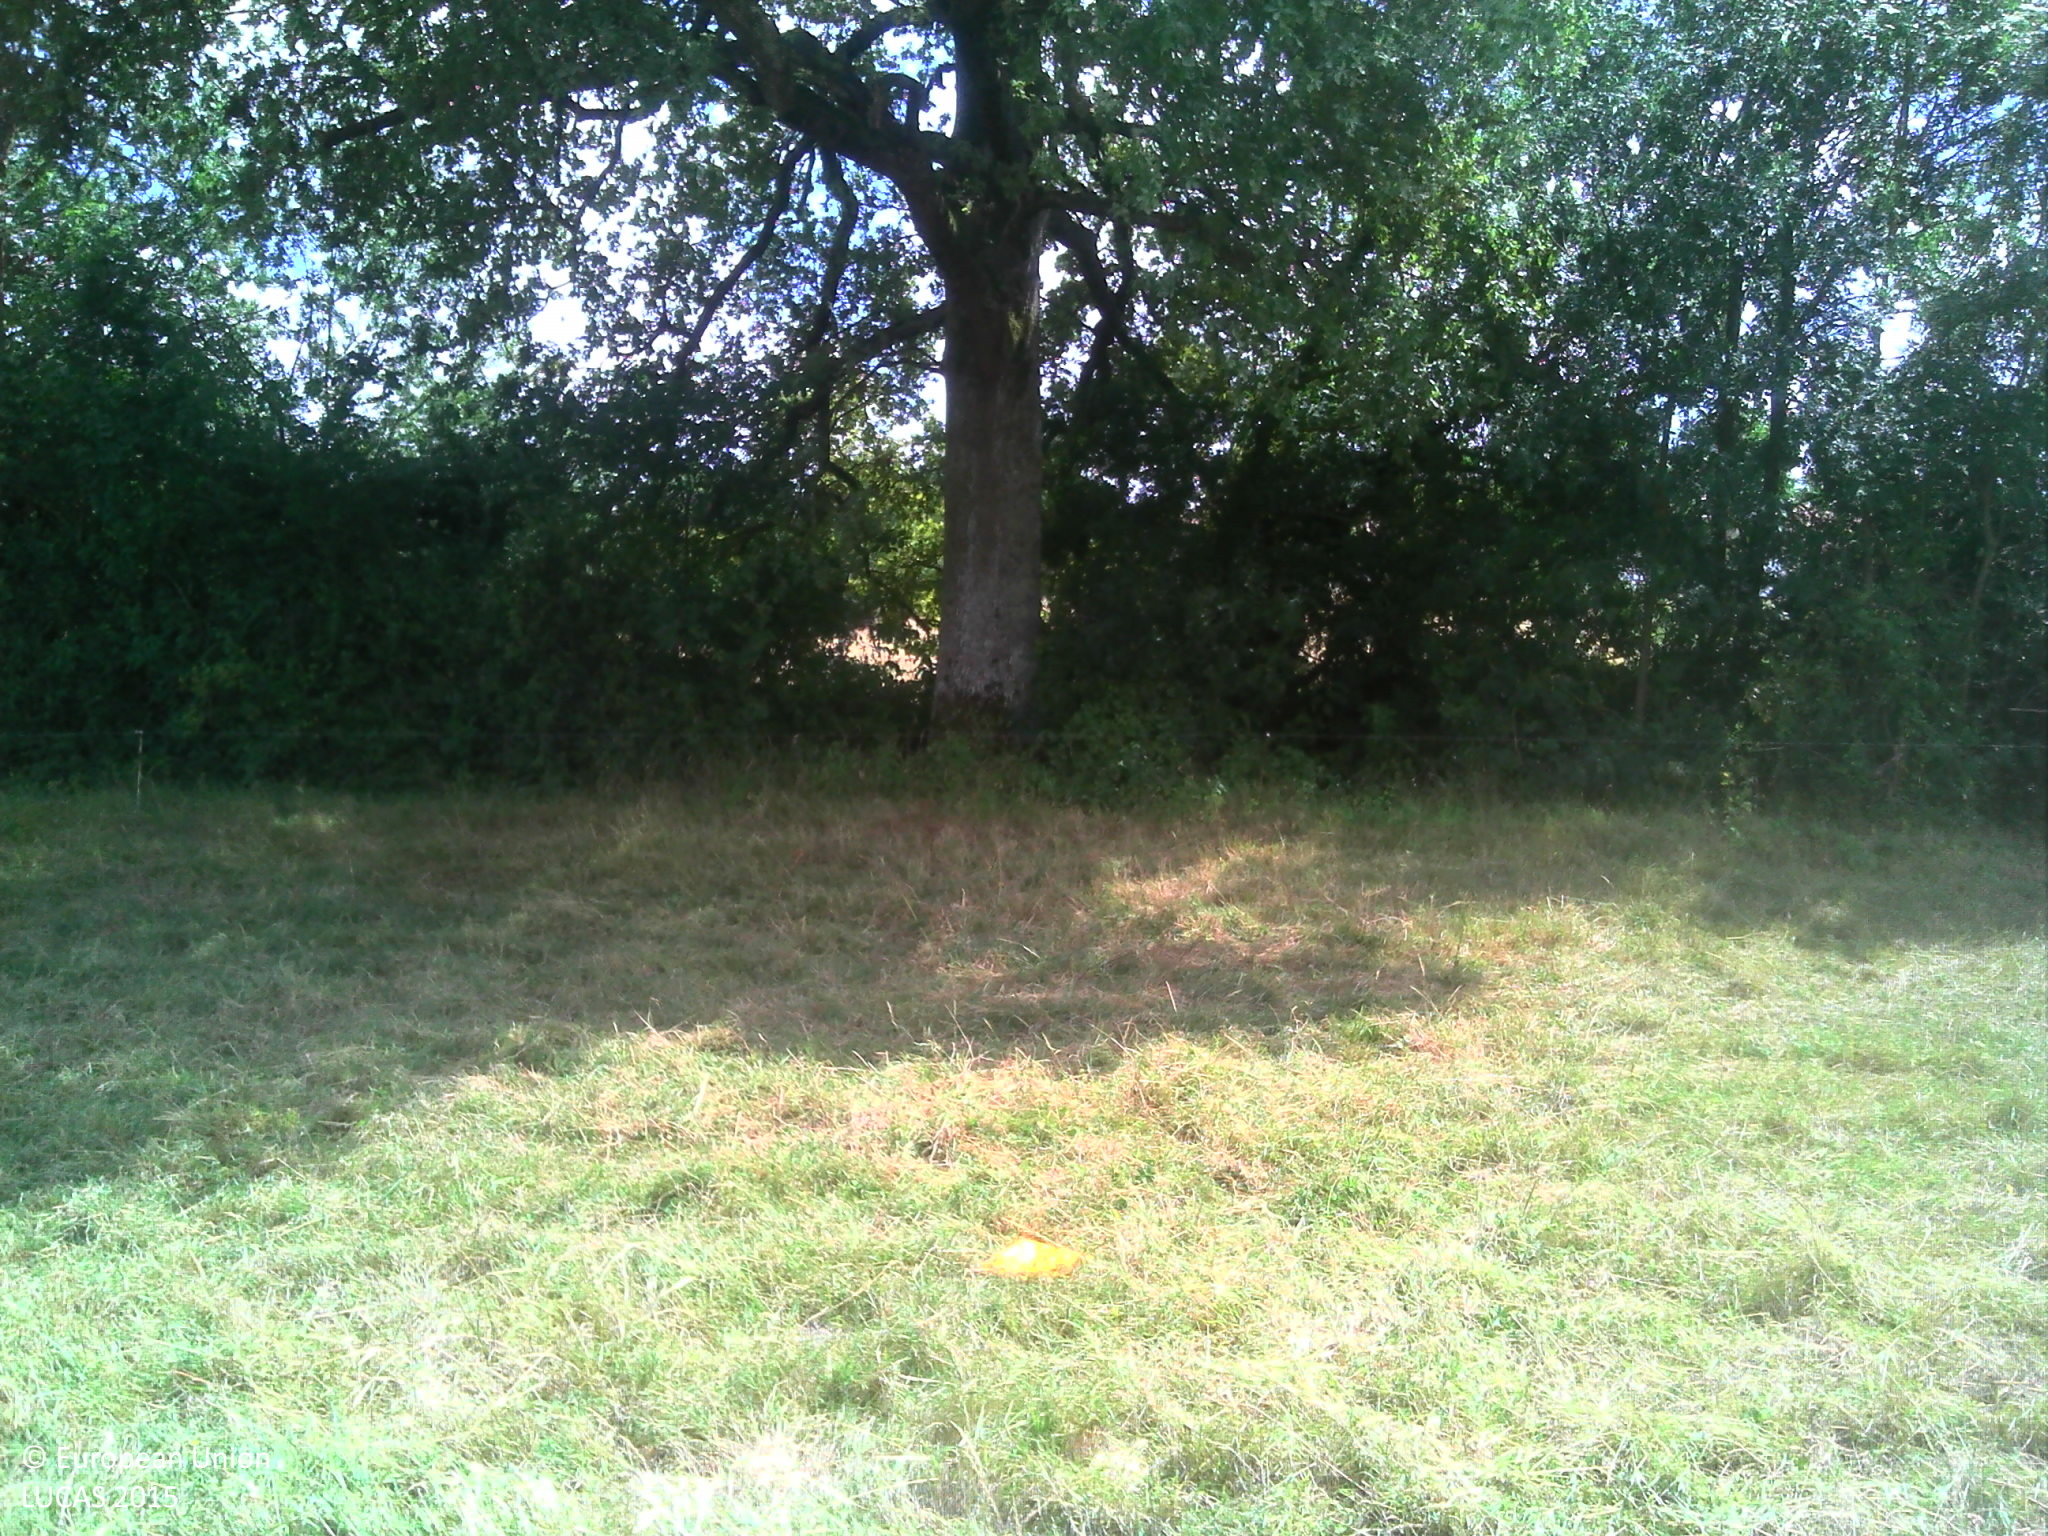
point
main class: Grassland
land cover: Grassland without tree/shrub cover
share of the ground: > 75 %
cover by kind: herbaceous plants 100 %
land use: Agriculture (excluding fallow land and kitchen gardens)
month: July
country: FR
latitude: 46.4923
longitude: -1.3313
